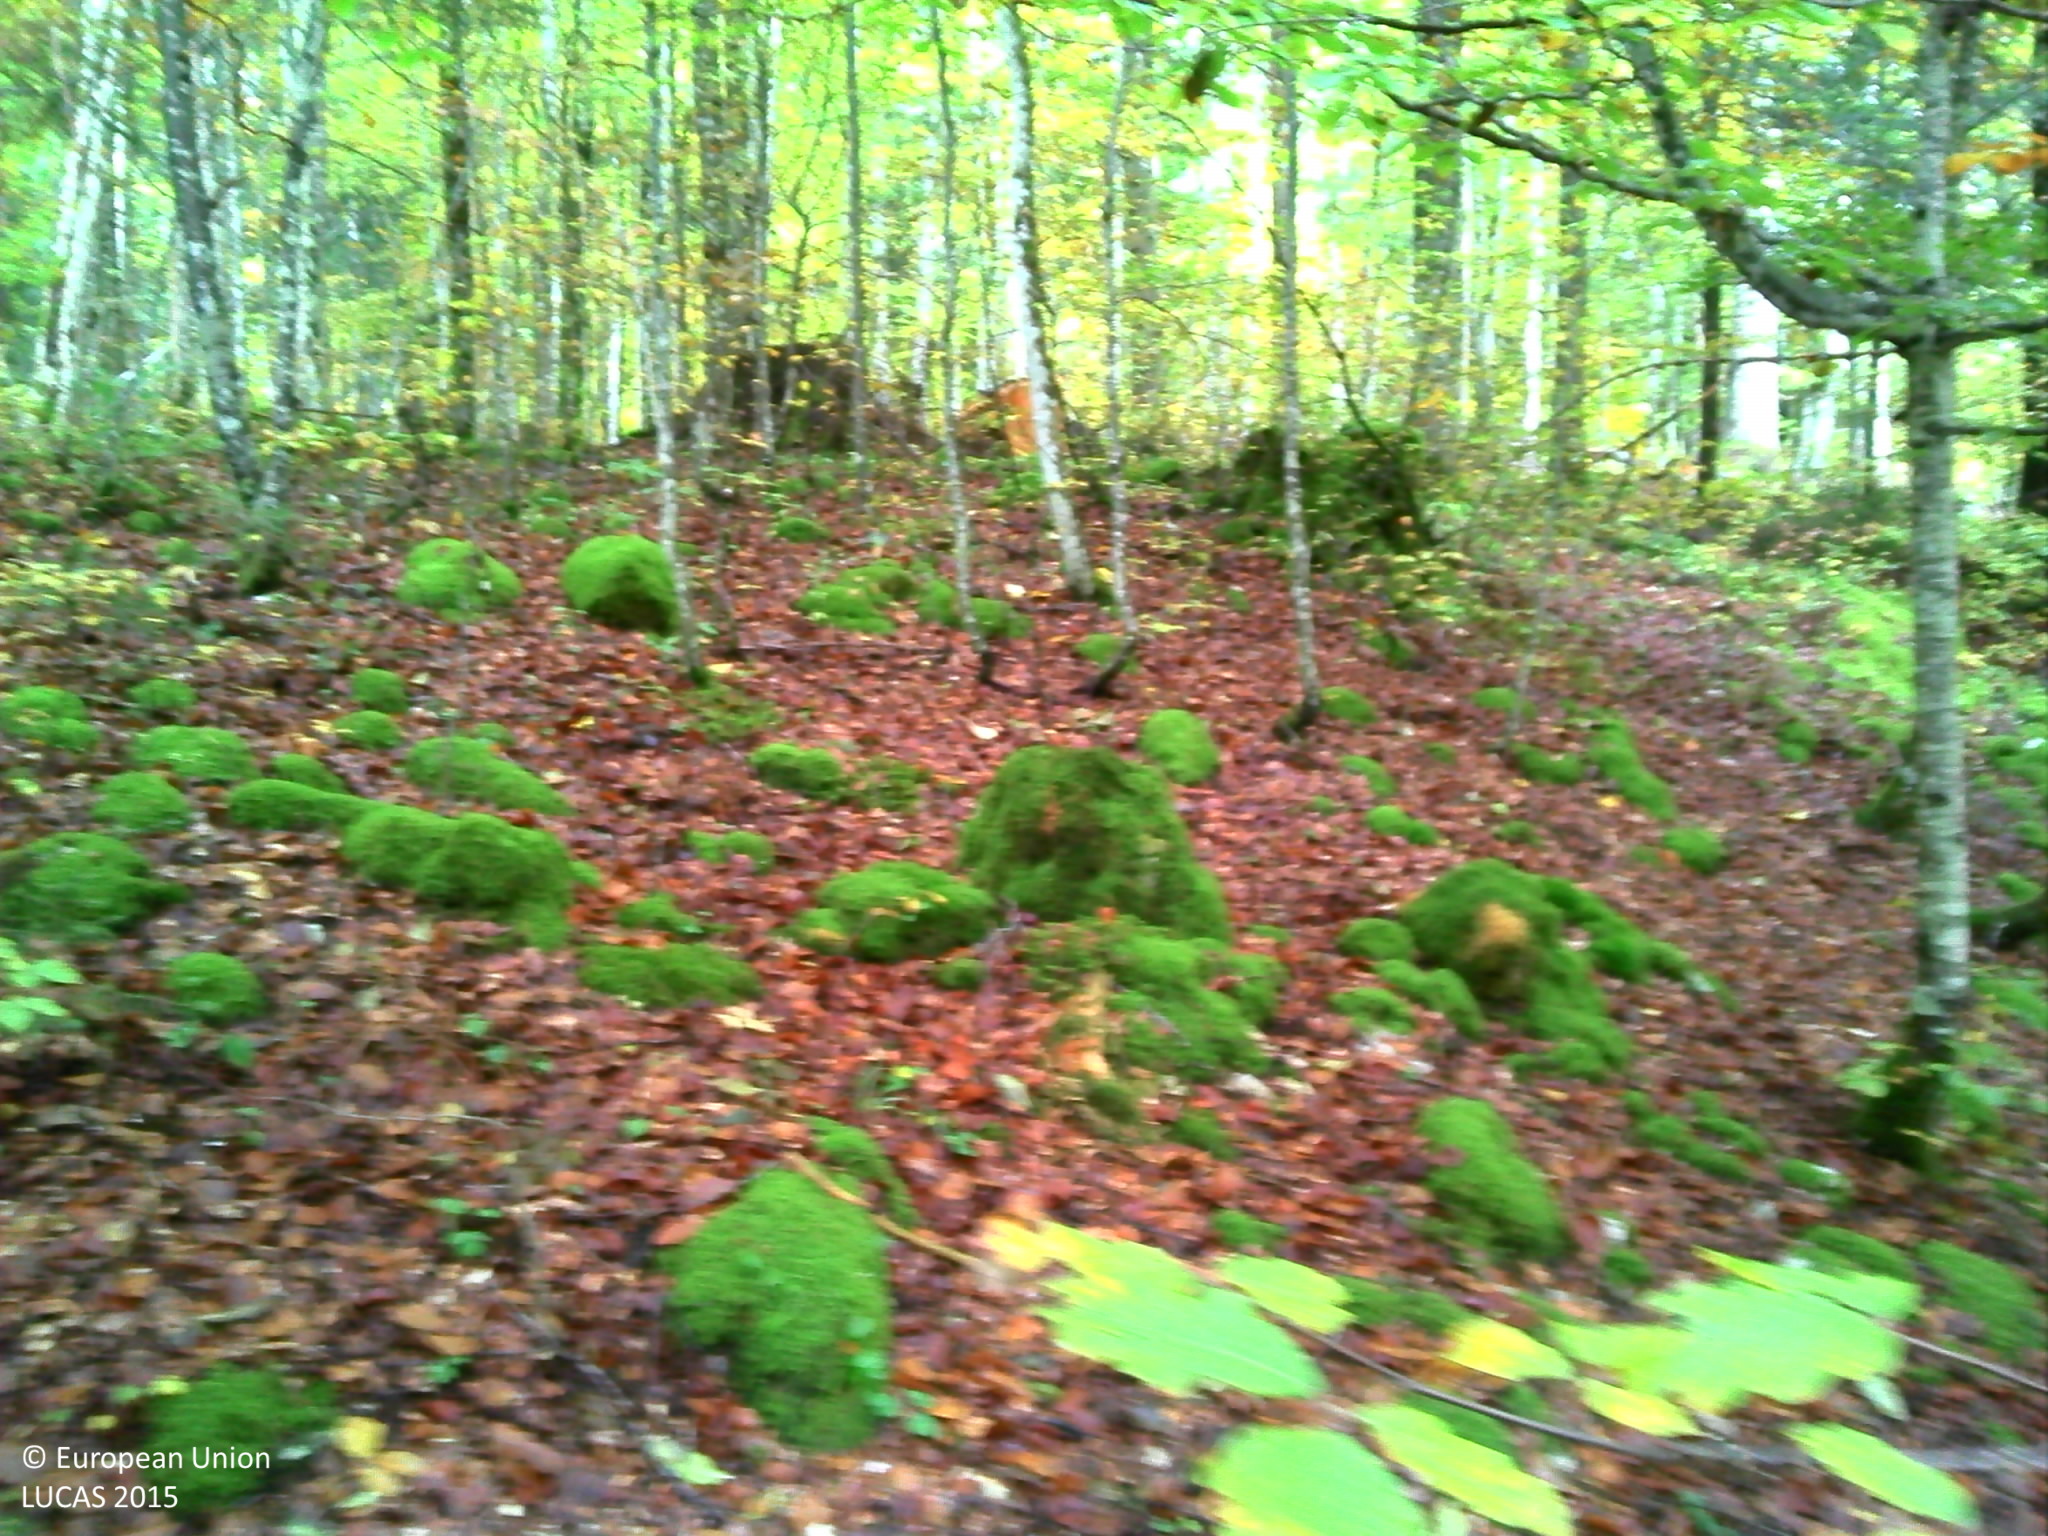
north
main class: Woodland
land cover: Spruce dominated mixed woodland
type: mountainous beech forest
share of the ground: 50 - 75 %
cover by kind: broadleaved forest trees 40 %, coniferous forest trees 30 %, unconsolidated bare surface 20 %, lichens and mosses 5 %, consolidated bare surface 5 %
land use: Forestry
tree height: > 5 m
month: October
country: FR
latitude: 46.7594
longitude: 6.4022
